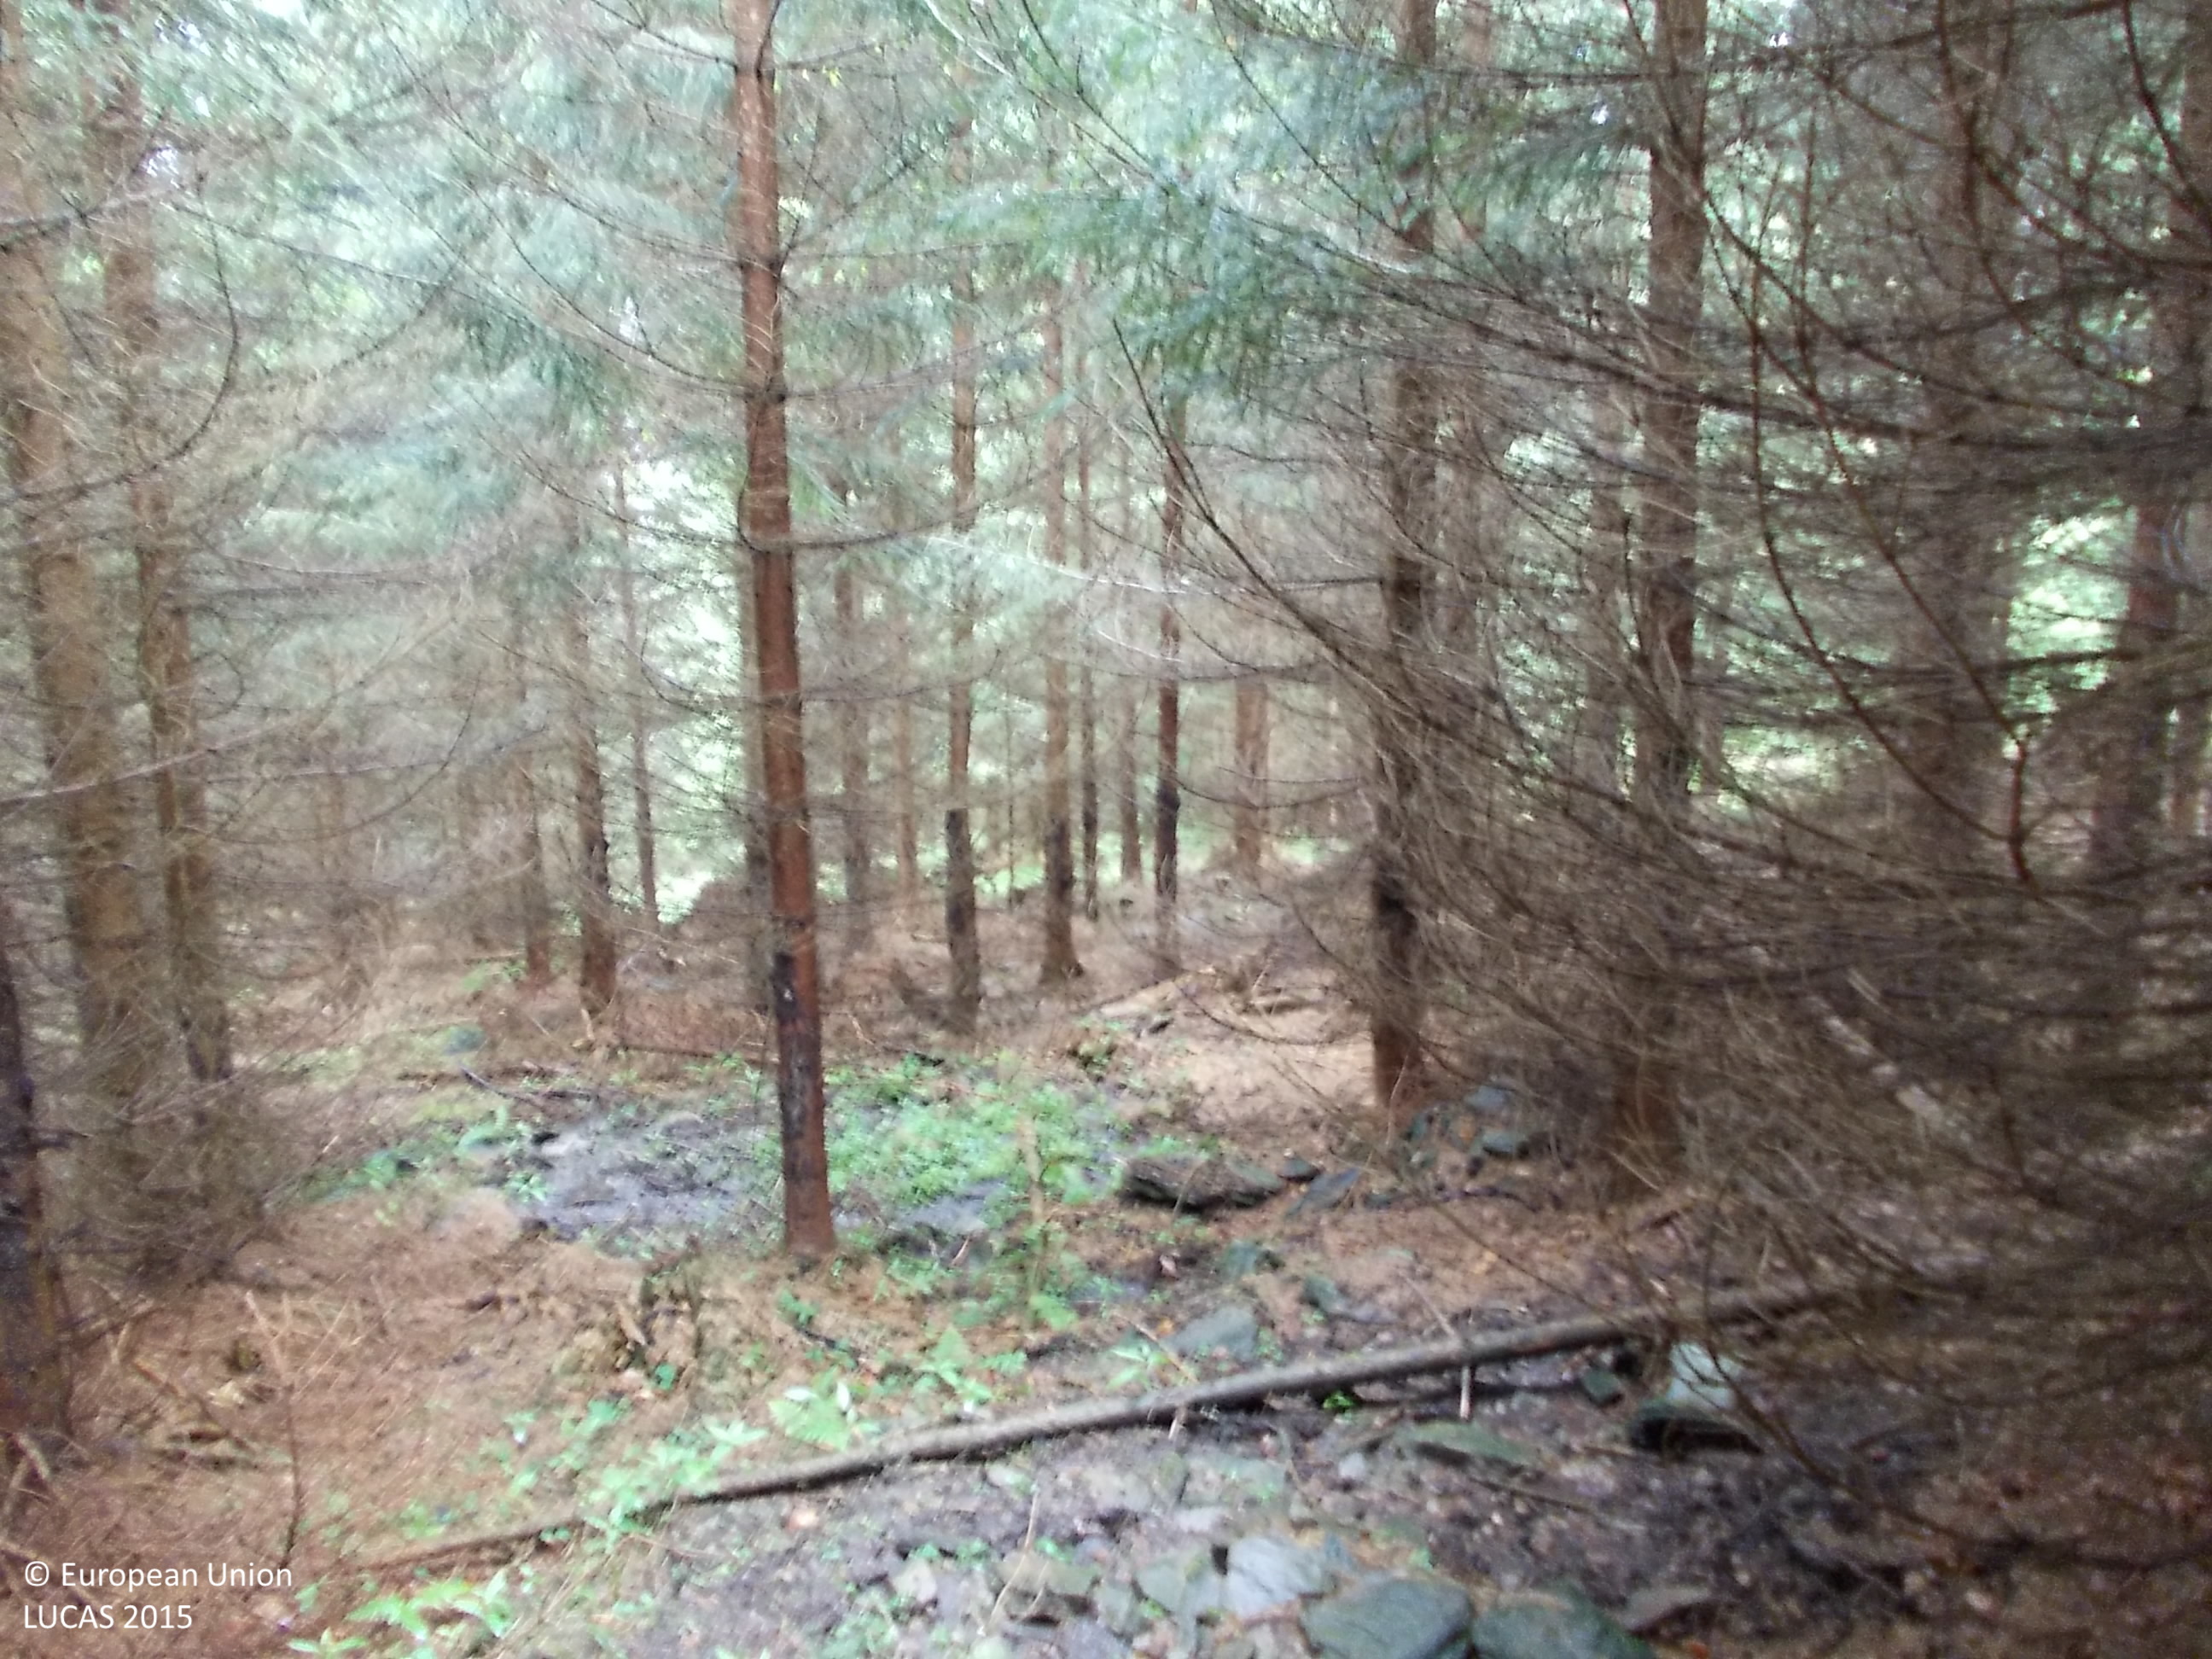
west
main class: Woodland
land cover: Spruce dominated coniferous woodland
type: hemiboreal forest and nemoral coniferous forest and mixed broadleaved-coniferous forest
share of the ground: > 75 %
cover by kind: coniferous forest trees 90 %, lichens and mosses 5 %
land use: Forestry
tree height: > 5 m
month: June
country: CZ
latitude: 48.9673
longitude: 13.8386
